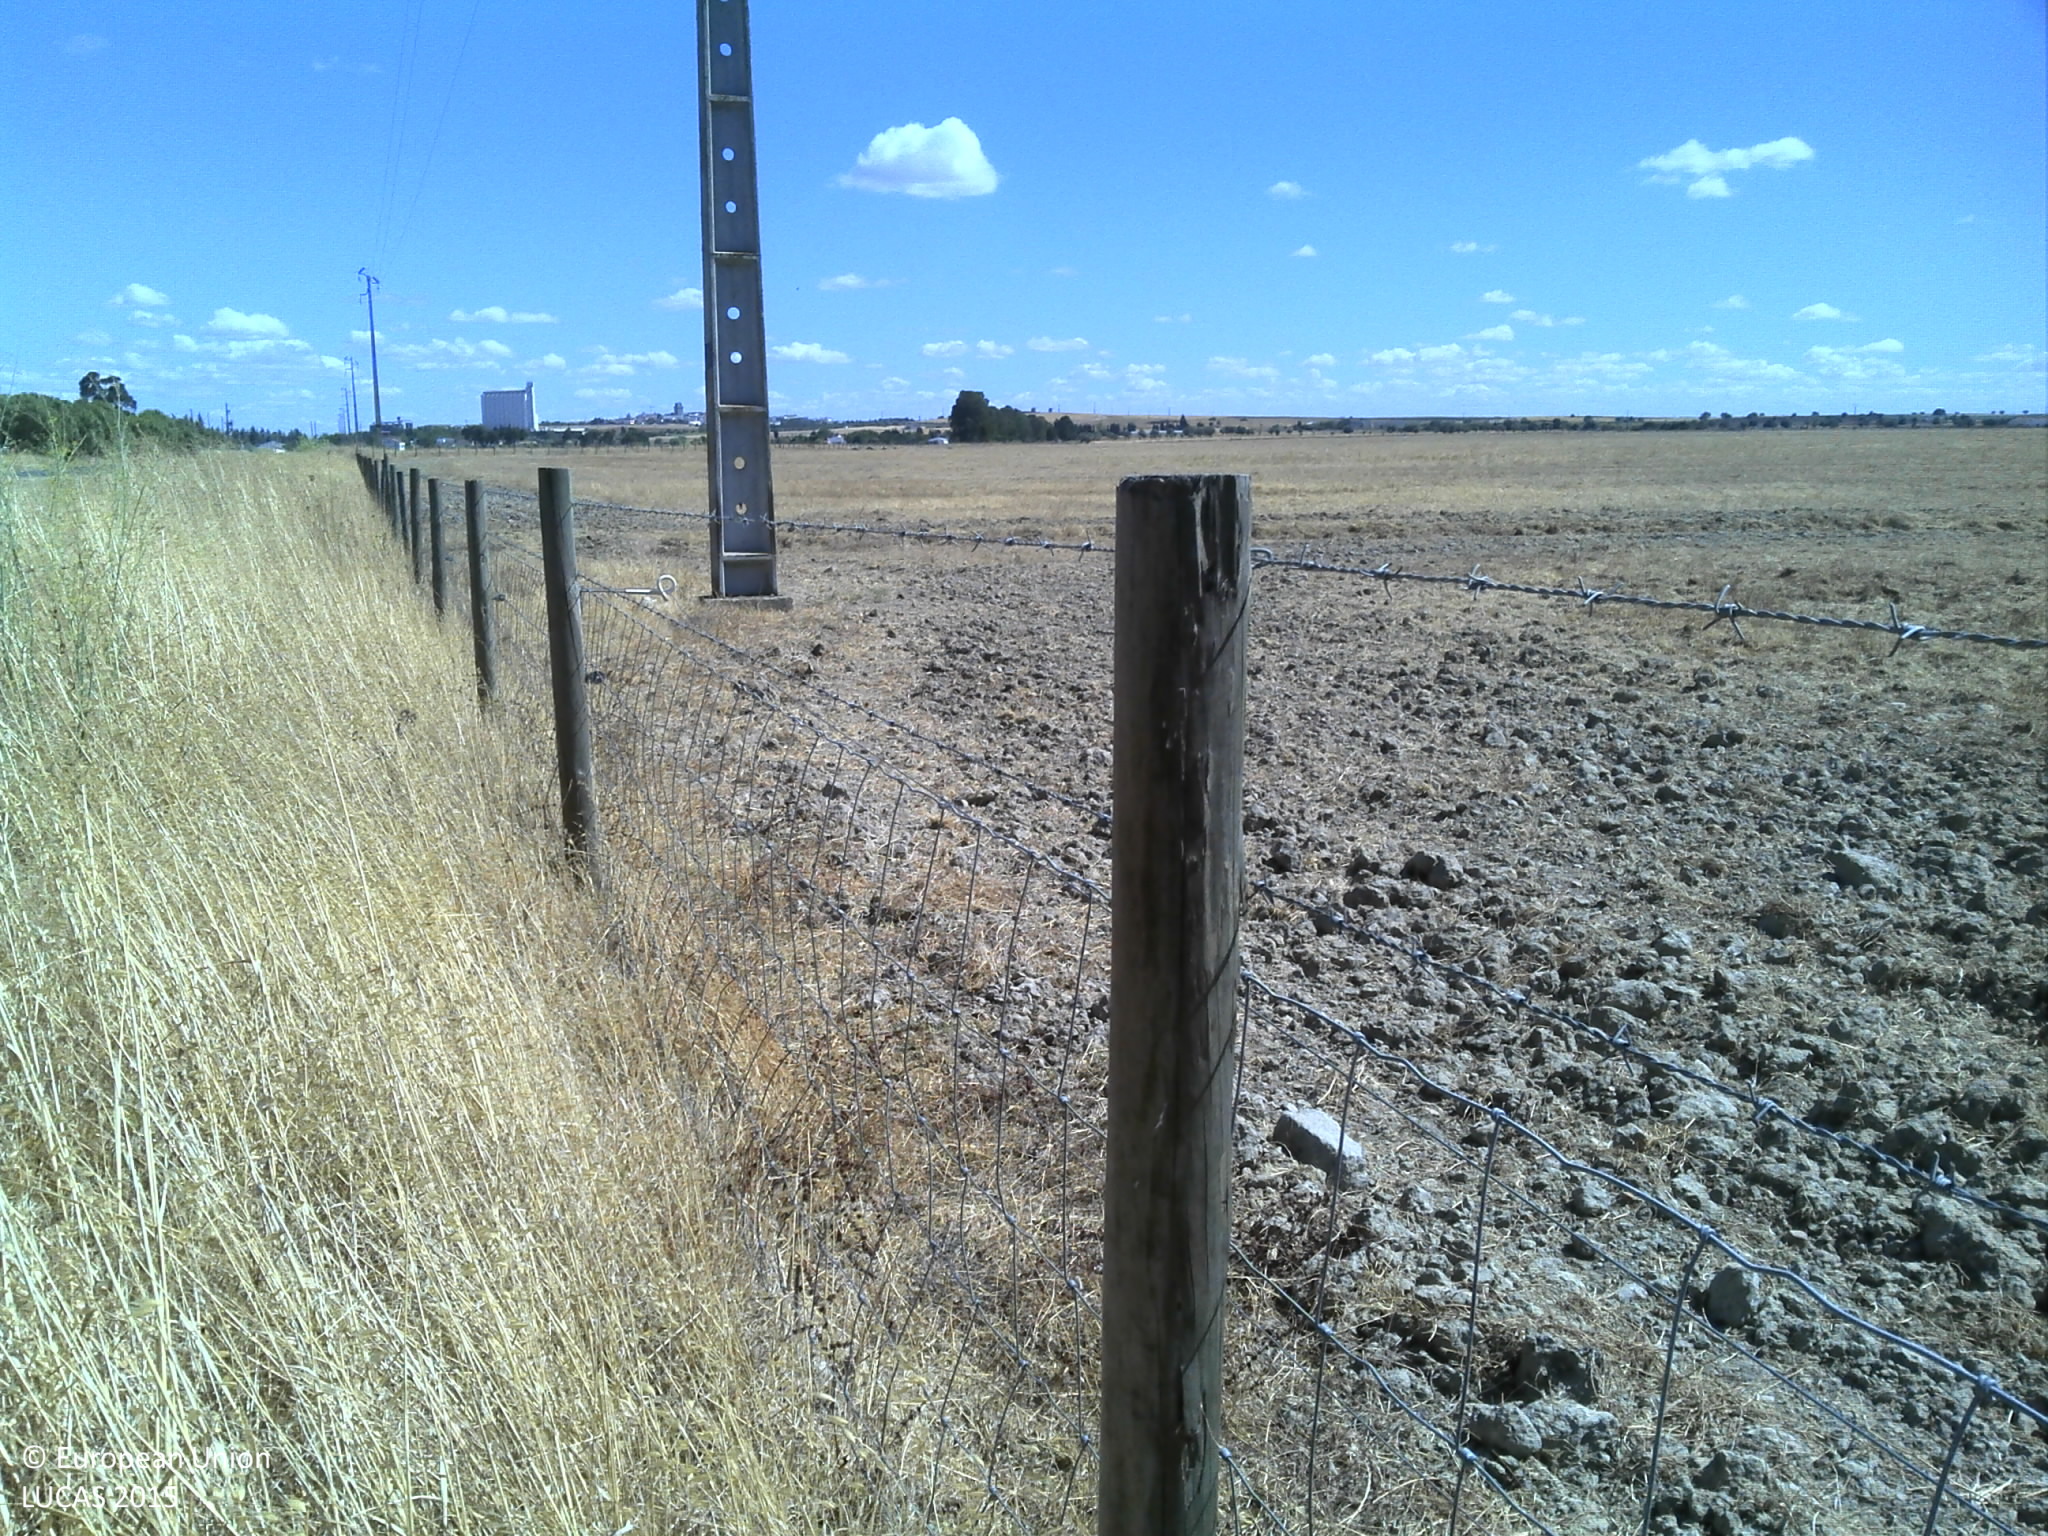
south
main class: Grassland
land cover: Grassland without tree/shrub cover
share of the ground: 50 - 75 %
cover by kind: herbaceous plants 75 %, unconsolidated bare surface 25 %
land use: Agriculture (excluding fallow land and kitchen gardens)
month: July
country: PT
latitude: 38.0537
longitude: -7.8870
